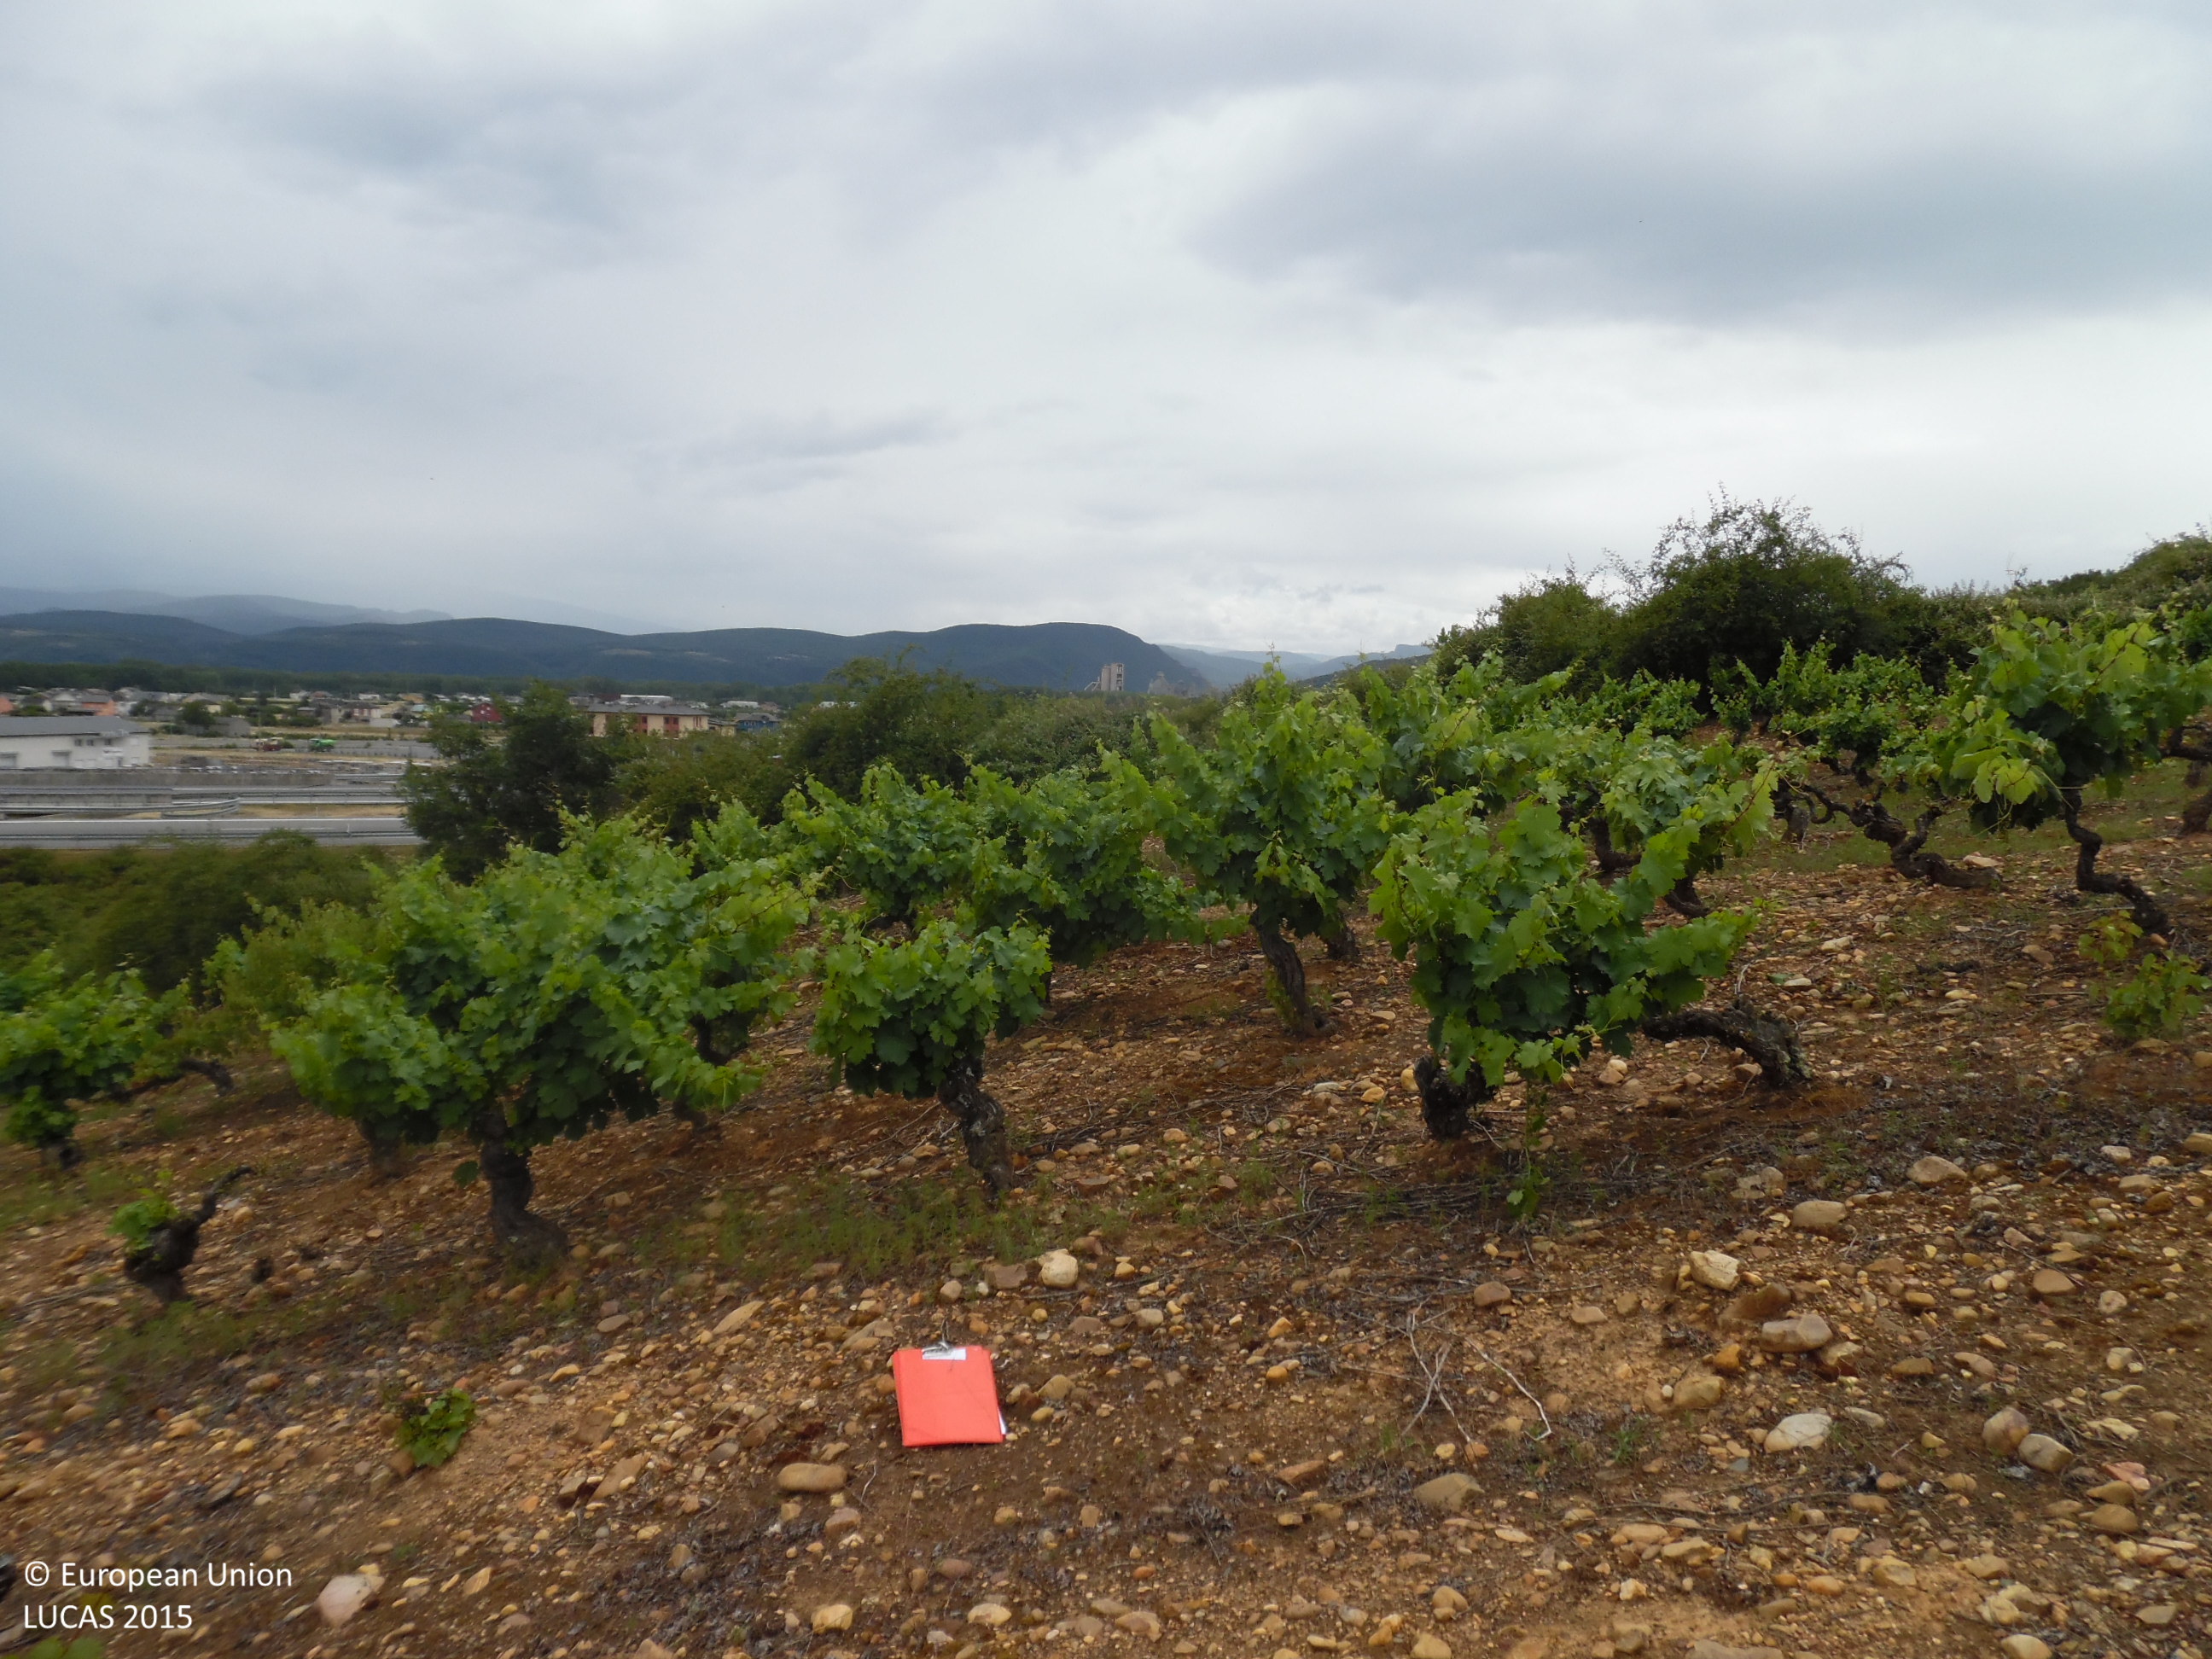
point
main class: Cropland
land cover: Vineyards
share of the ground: 50 - 75 %
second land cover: Other bare soil
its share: > 75 %
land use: Agriculture (excluding fallow land and kitchen gardens)
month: June
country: ES
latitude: 42.5720
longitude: -6.7529
